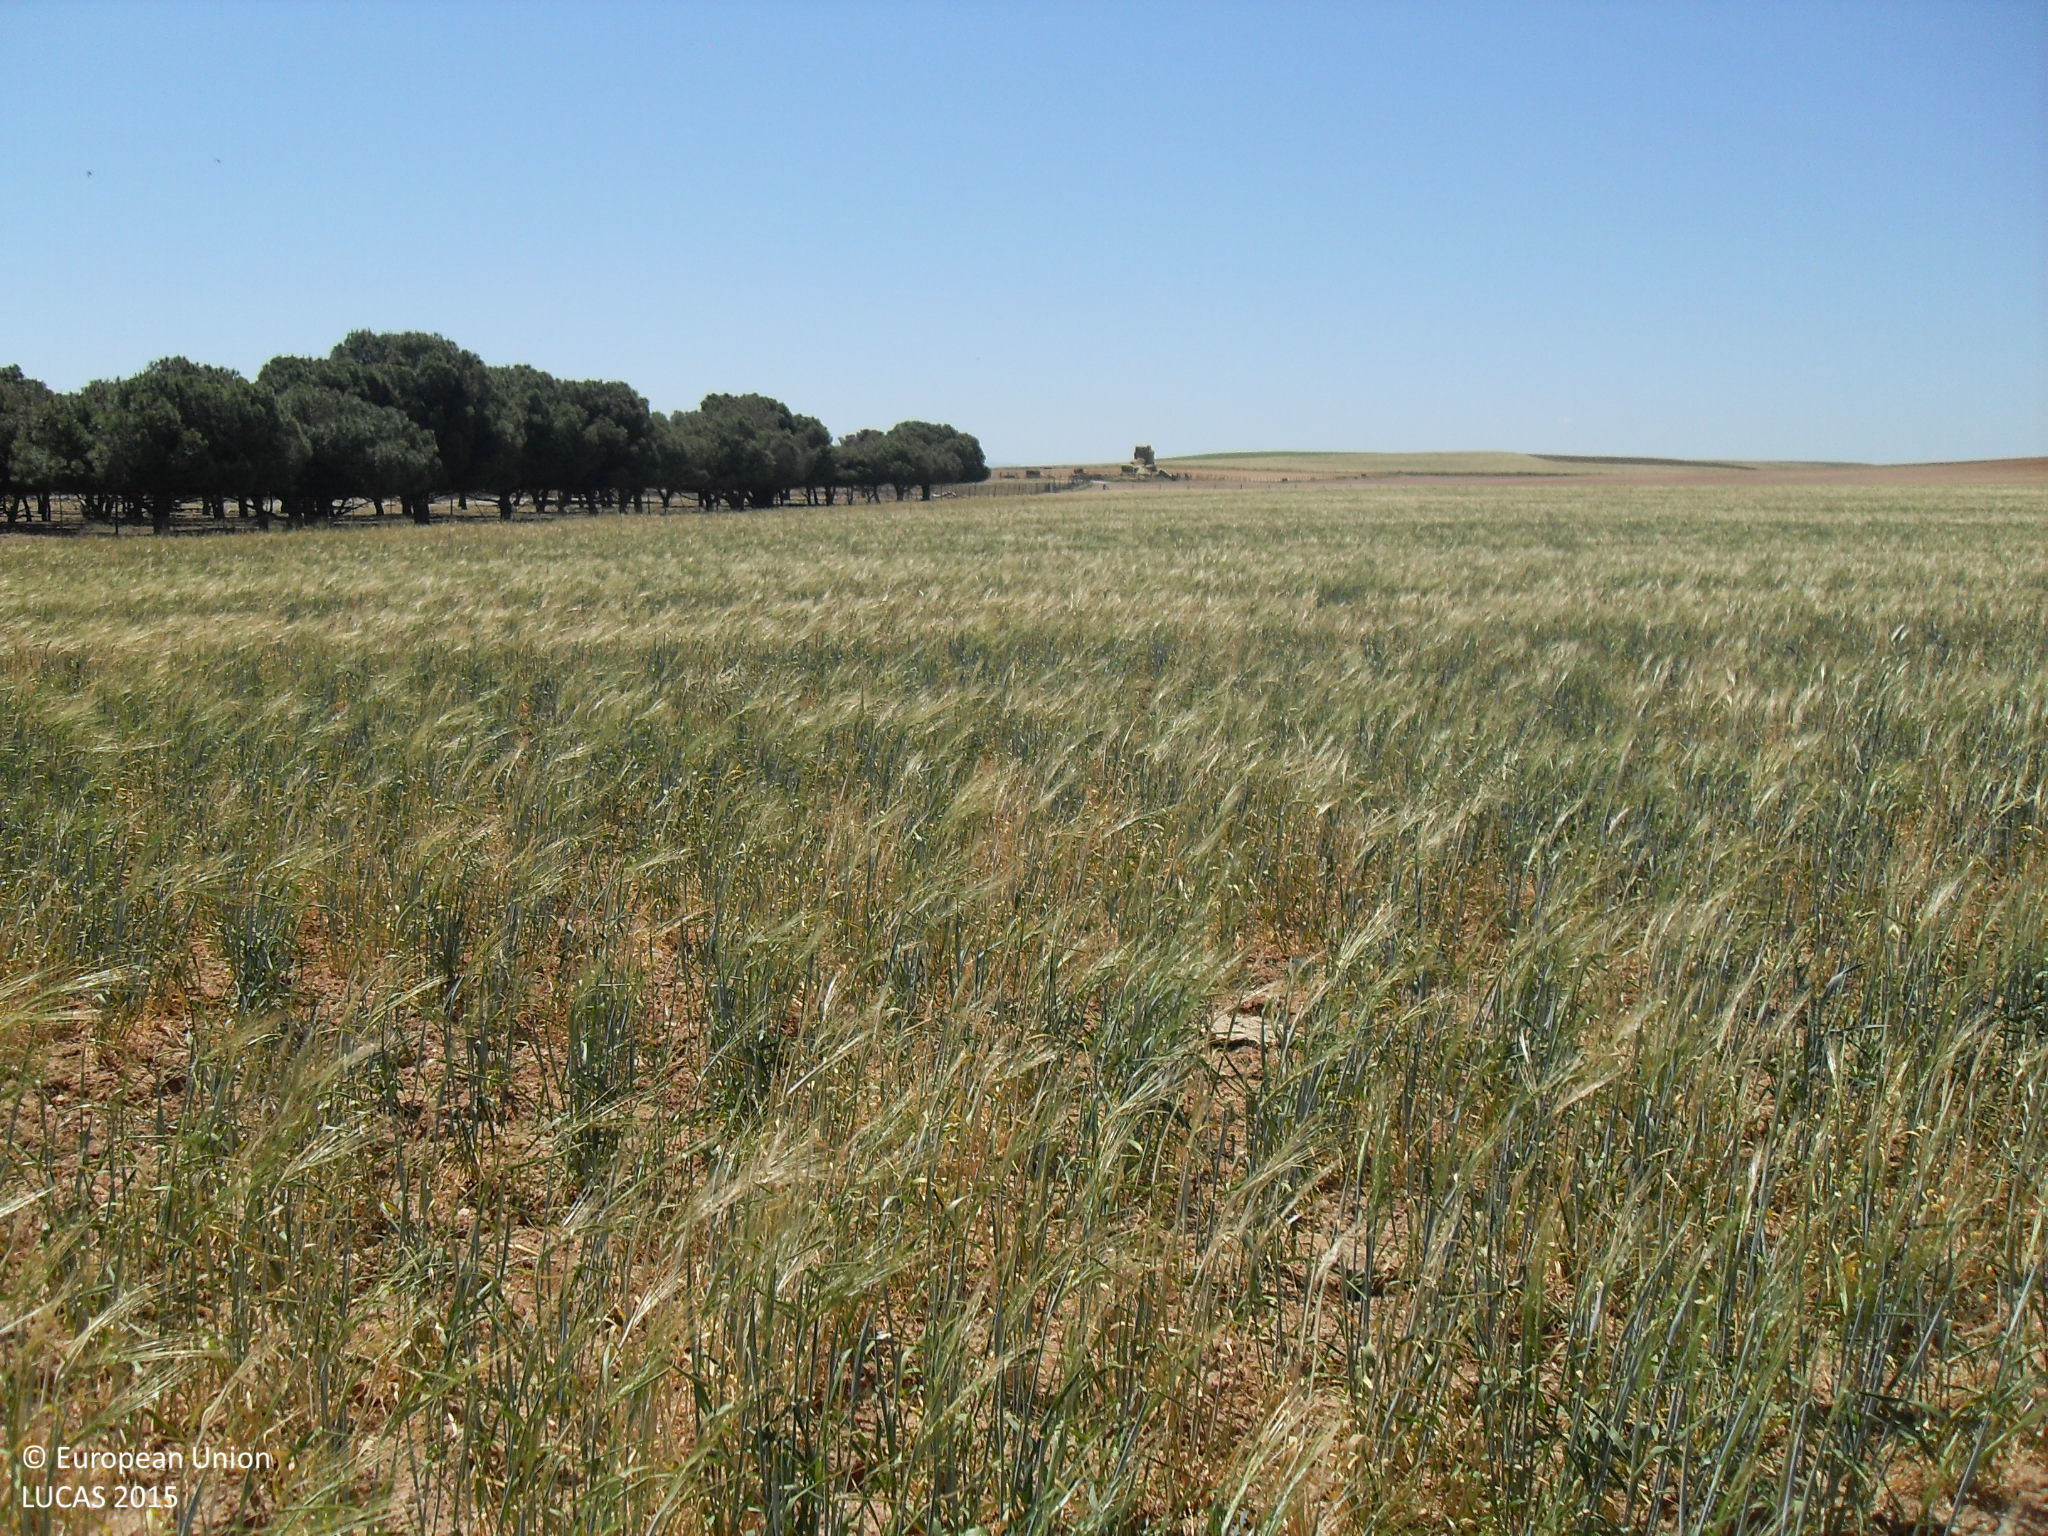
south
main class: Cropland
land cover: Barley
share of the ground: > 75 %
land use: Agriculture (excluding fallow land and kitchen gardens)
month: May
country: ES
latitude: 41.1231
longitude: -5.2578
